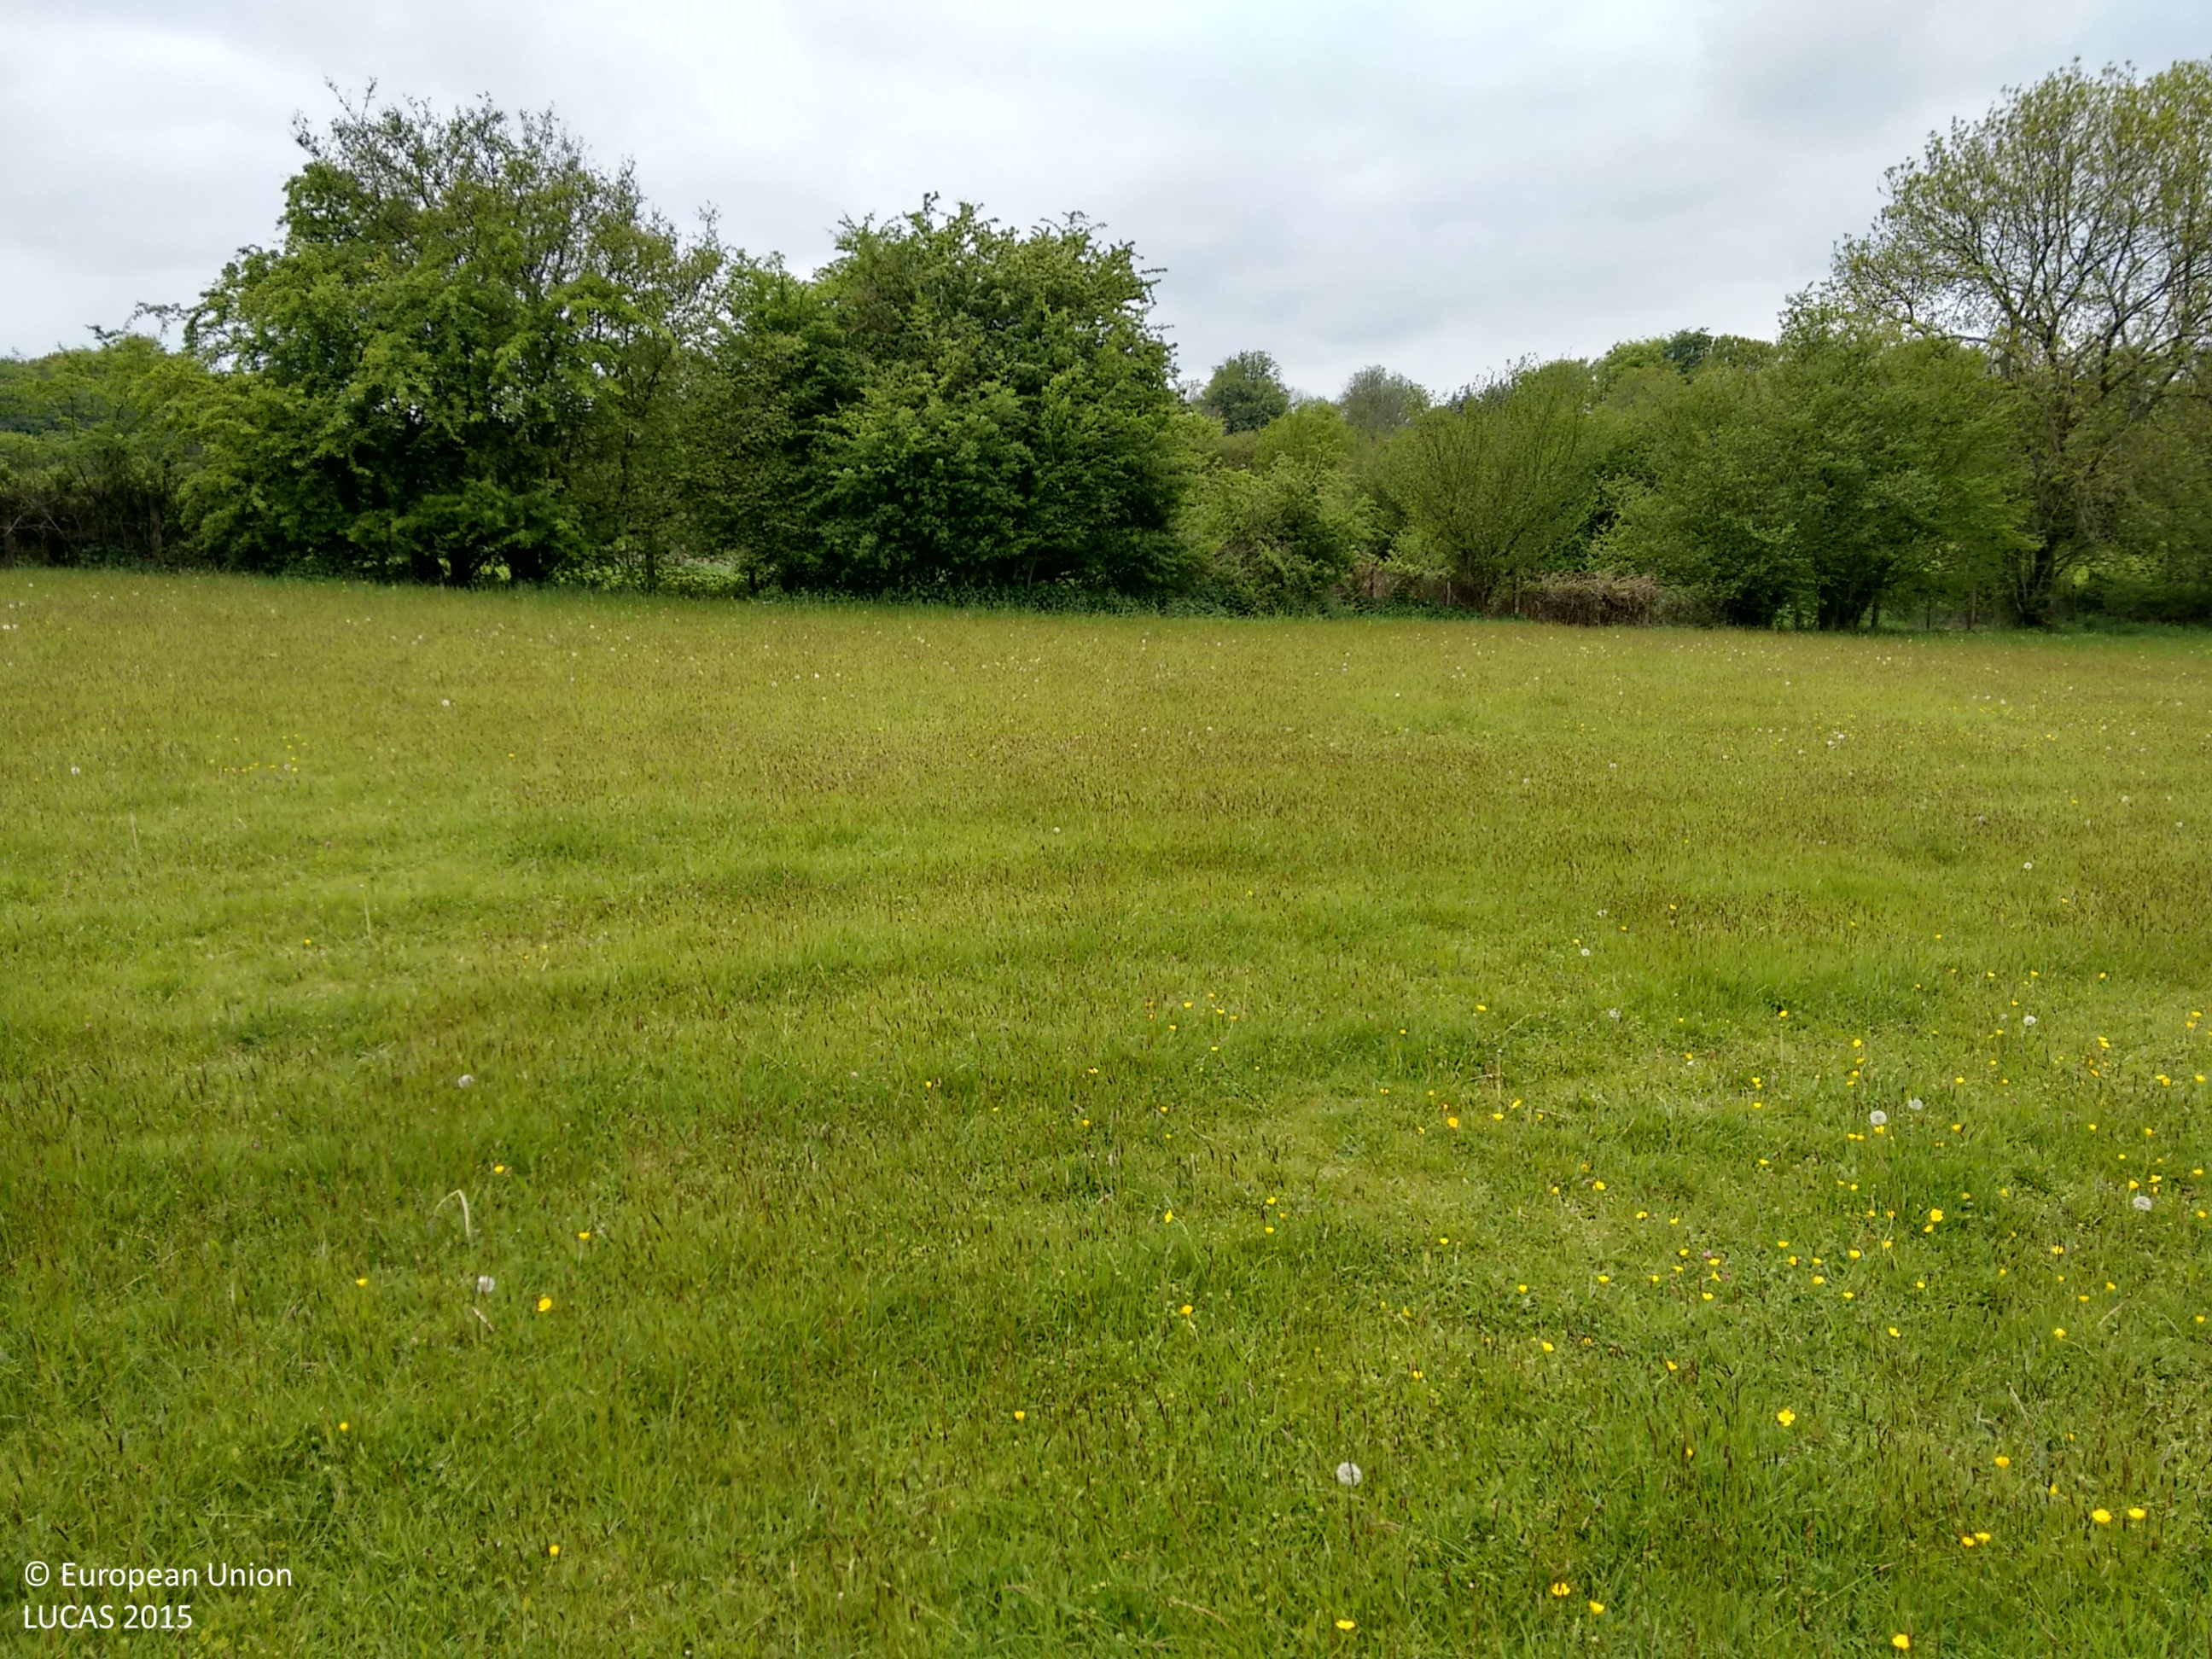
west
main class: Grassland
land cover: Grassland without tree/shrub cover
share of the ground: > 75 %
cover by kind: herbaceous plants 100 %
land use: Agriculture (excluding fallow land and kitchen gardens)
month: May
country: GB
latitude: 51.0315
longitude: -0.9811
